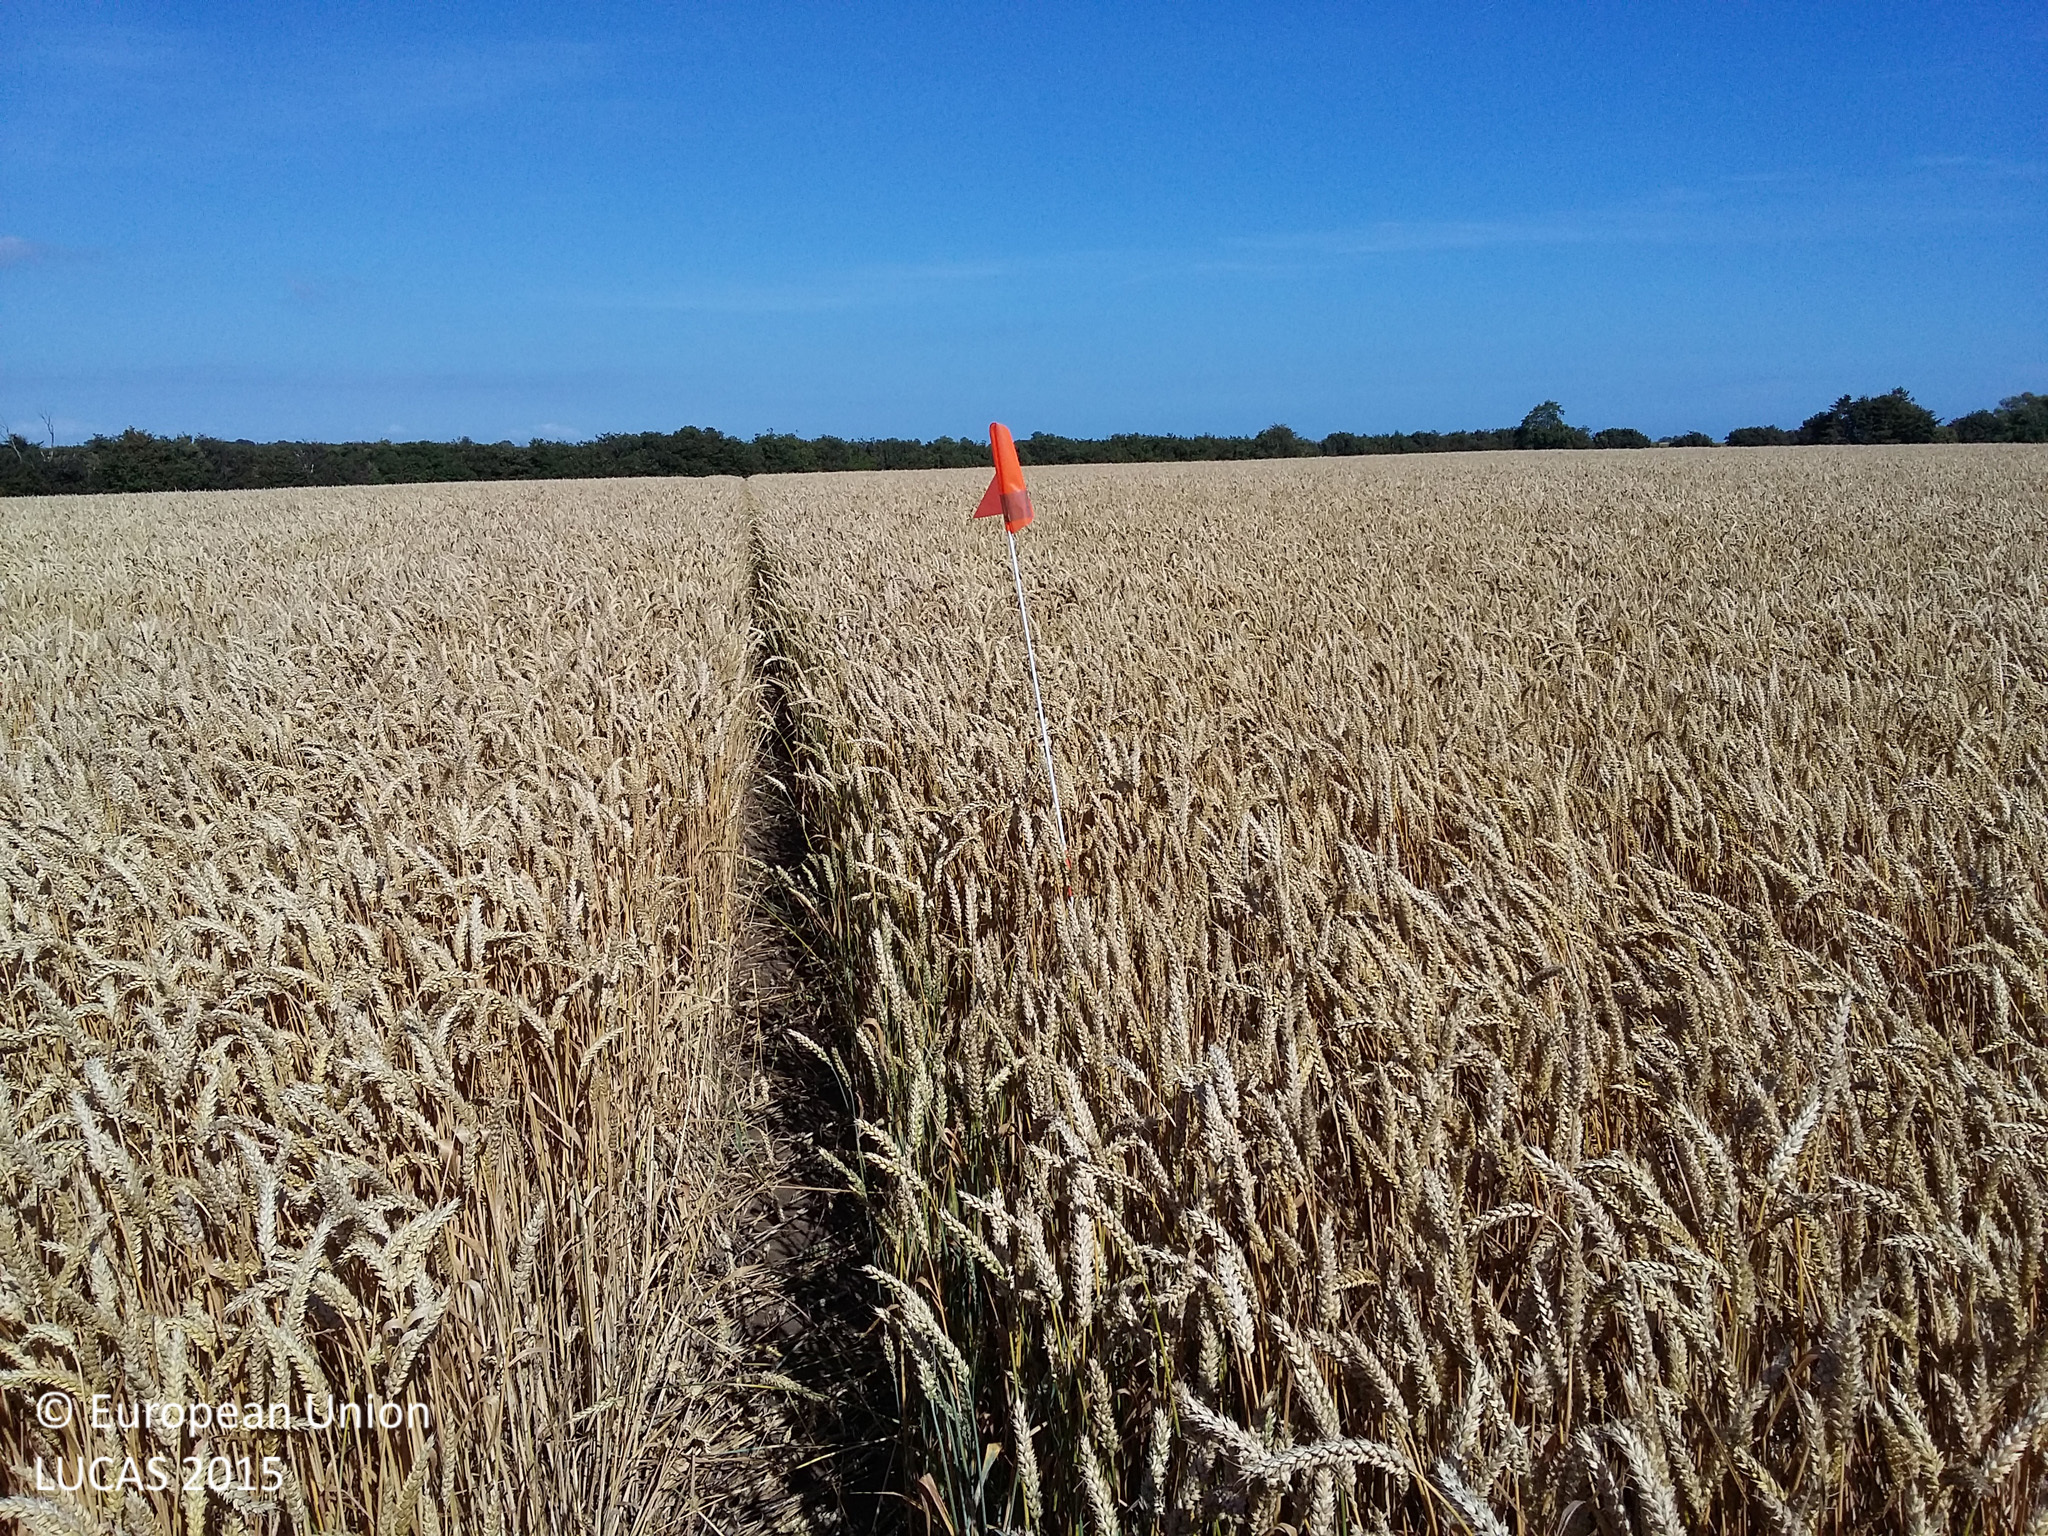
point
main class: Cropland
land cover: Common wheat
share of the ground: > 75 %
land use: Agriculture (excluding fallow land and kitchen gardens)
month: August
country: DK
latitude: 55.2499
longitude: 12.3109
